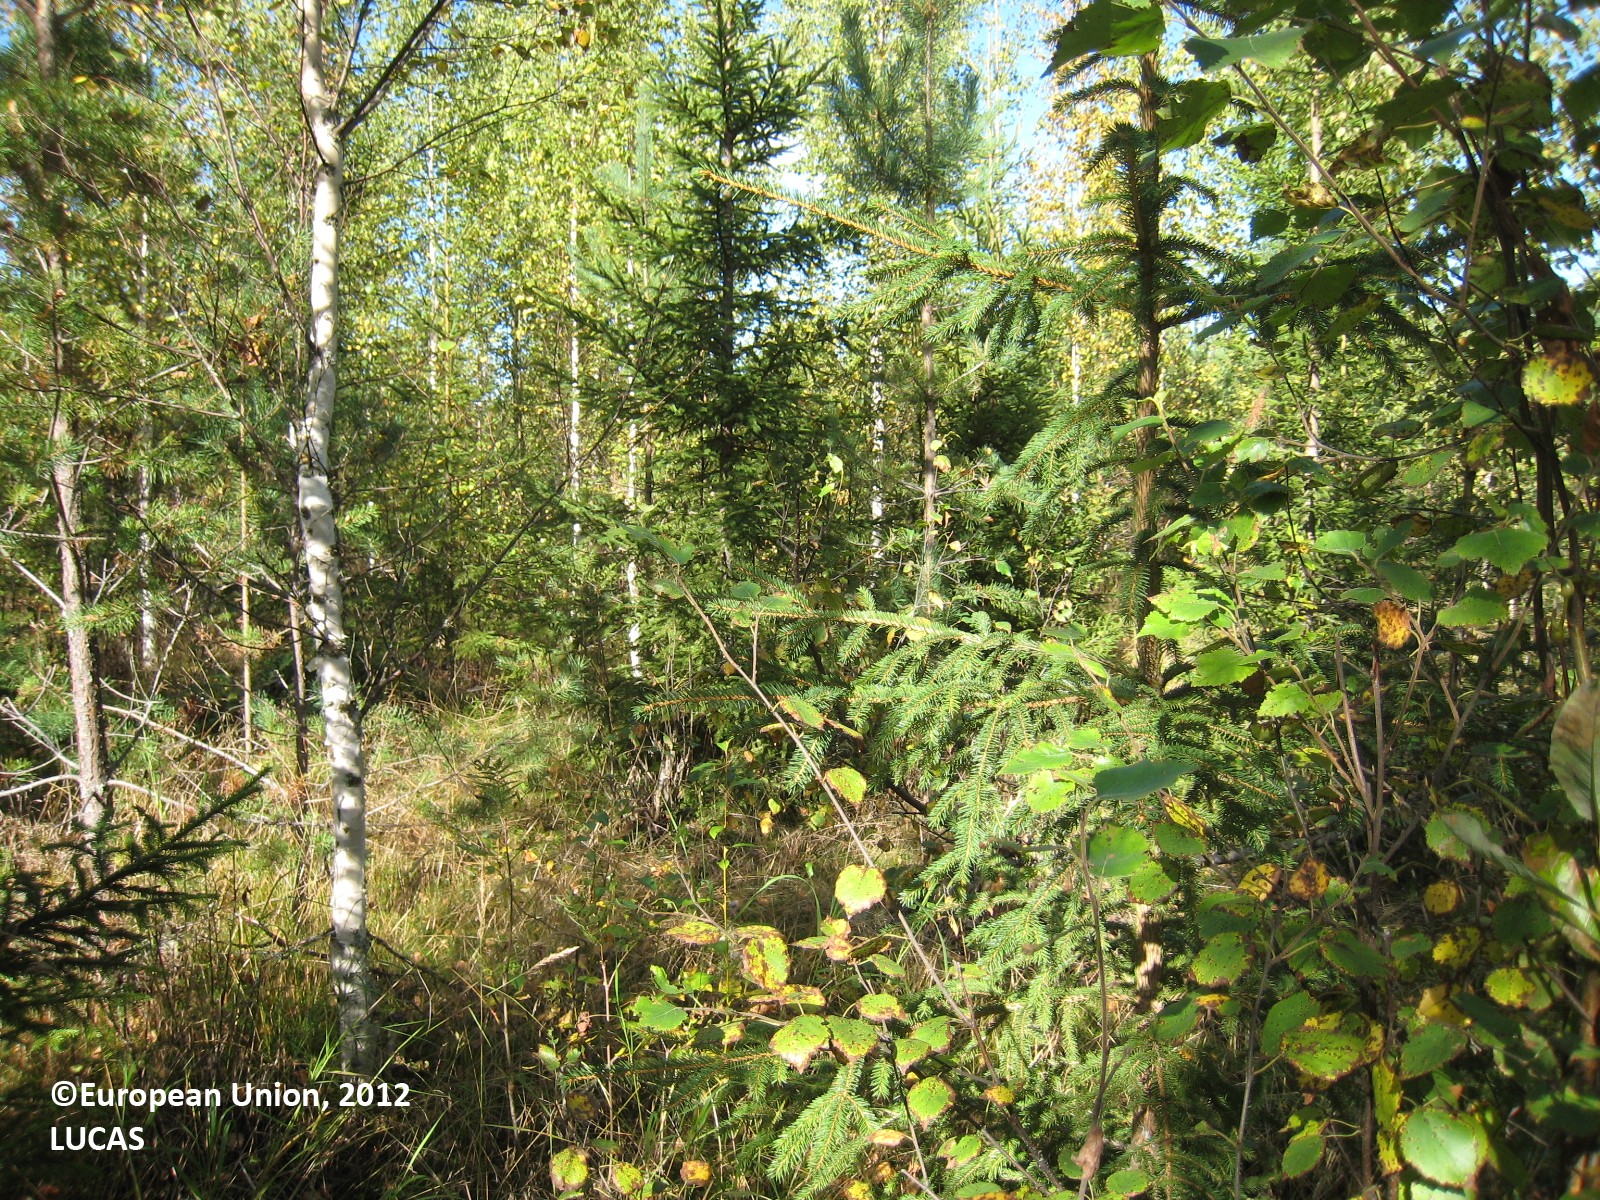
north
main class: Woodland
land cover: Other mixed woodland
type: boreal forest
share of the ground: > 75 %
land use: Forestry
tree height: > 5 m
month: September
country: FI
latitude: 63.0068
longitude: 26.8287
